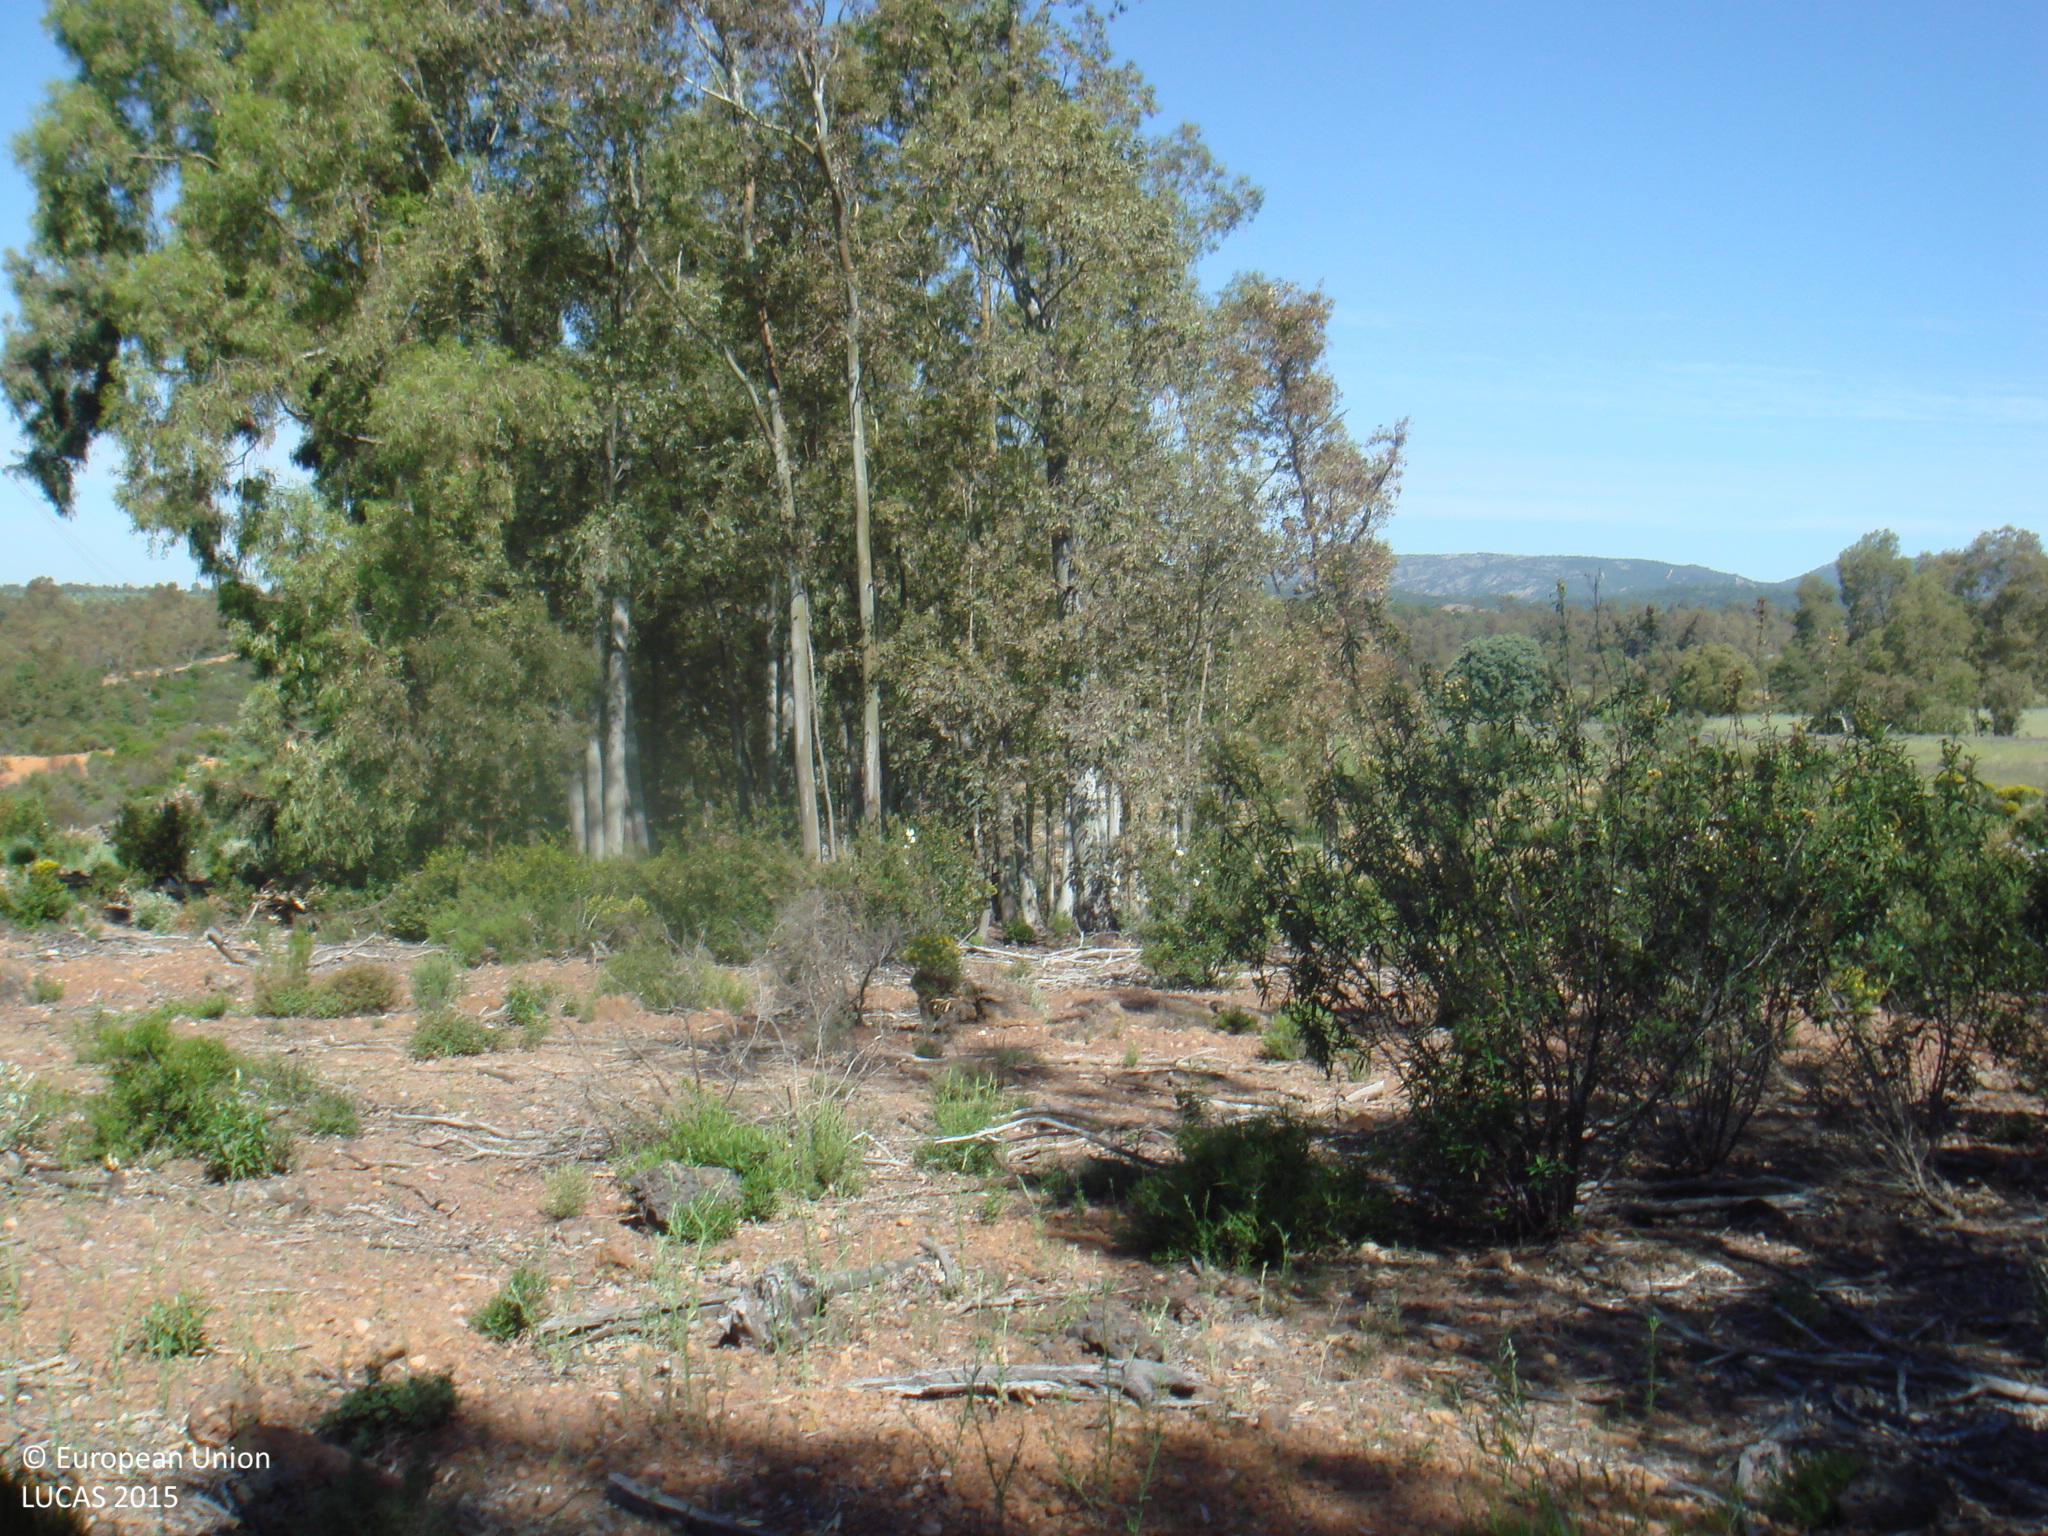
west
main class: Woodland
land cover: Broadleaved woodland
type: broadleaved evergreen forest
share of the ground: > 75 %
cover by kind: broadleaved forest trees 50 %, herbaceous plants 30 %, shrubs 20 %
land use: Forestry
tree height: > 5 m
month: May
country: ES
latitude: 38.4575
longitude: -4.4468
